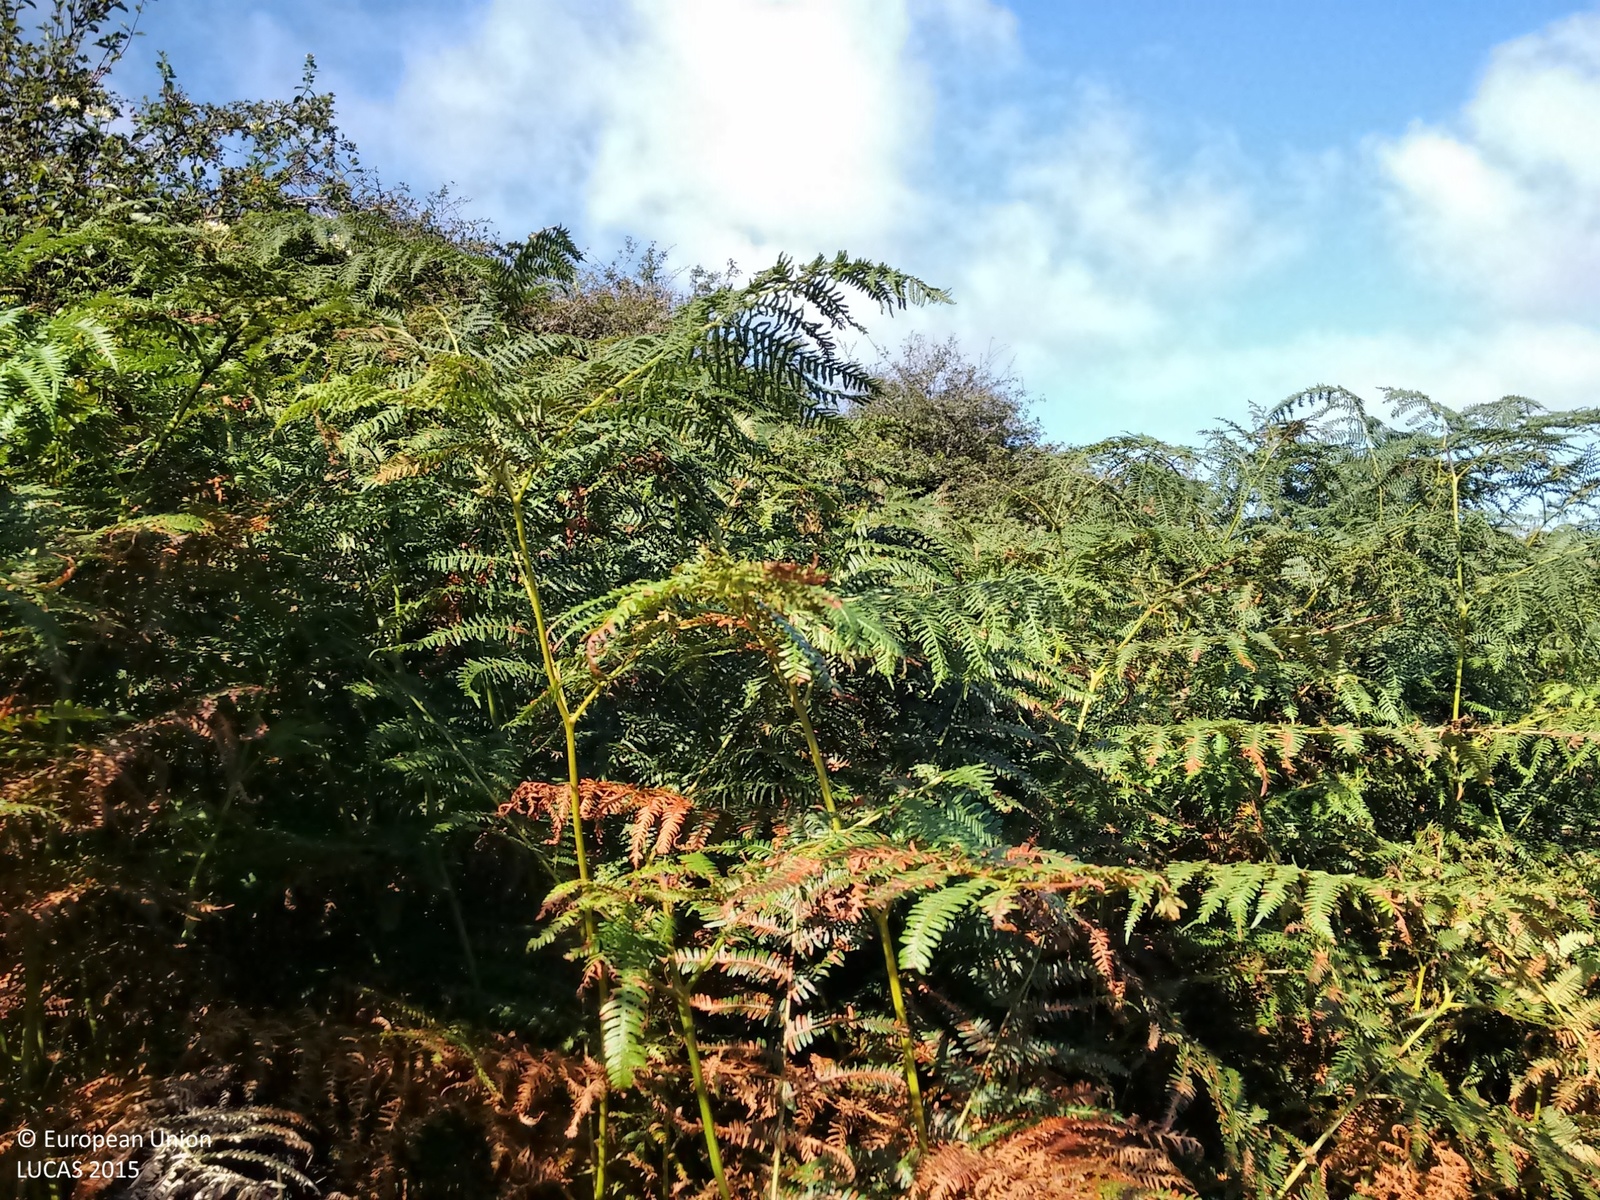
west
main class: Woodland
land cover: Broadleaved woodland
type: mesophytic deciduous forest
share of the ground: > 75 %
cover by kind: broadleaved forest trees 100 %
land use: Semi-natural and natural areas not in use
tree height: > 5 m
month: August
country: GB
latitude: 50.0904
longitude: -5.6031
